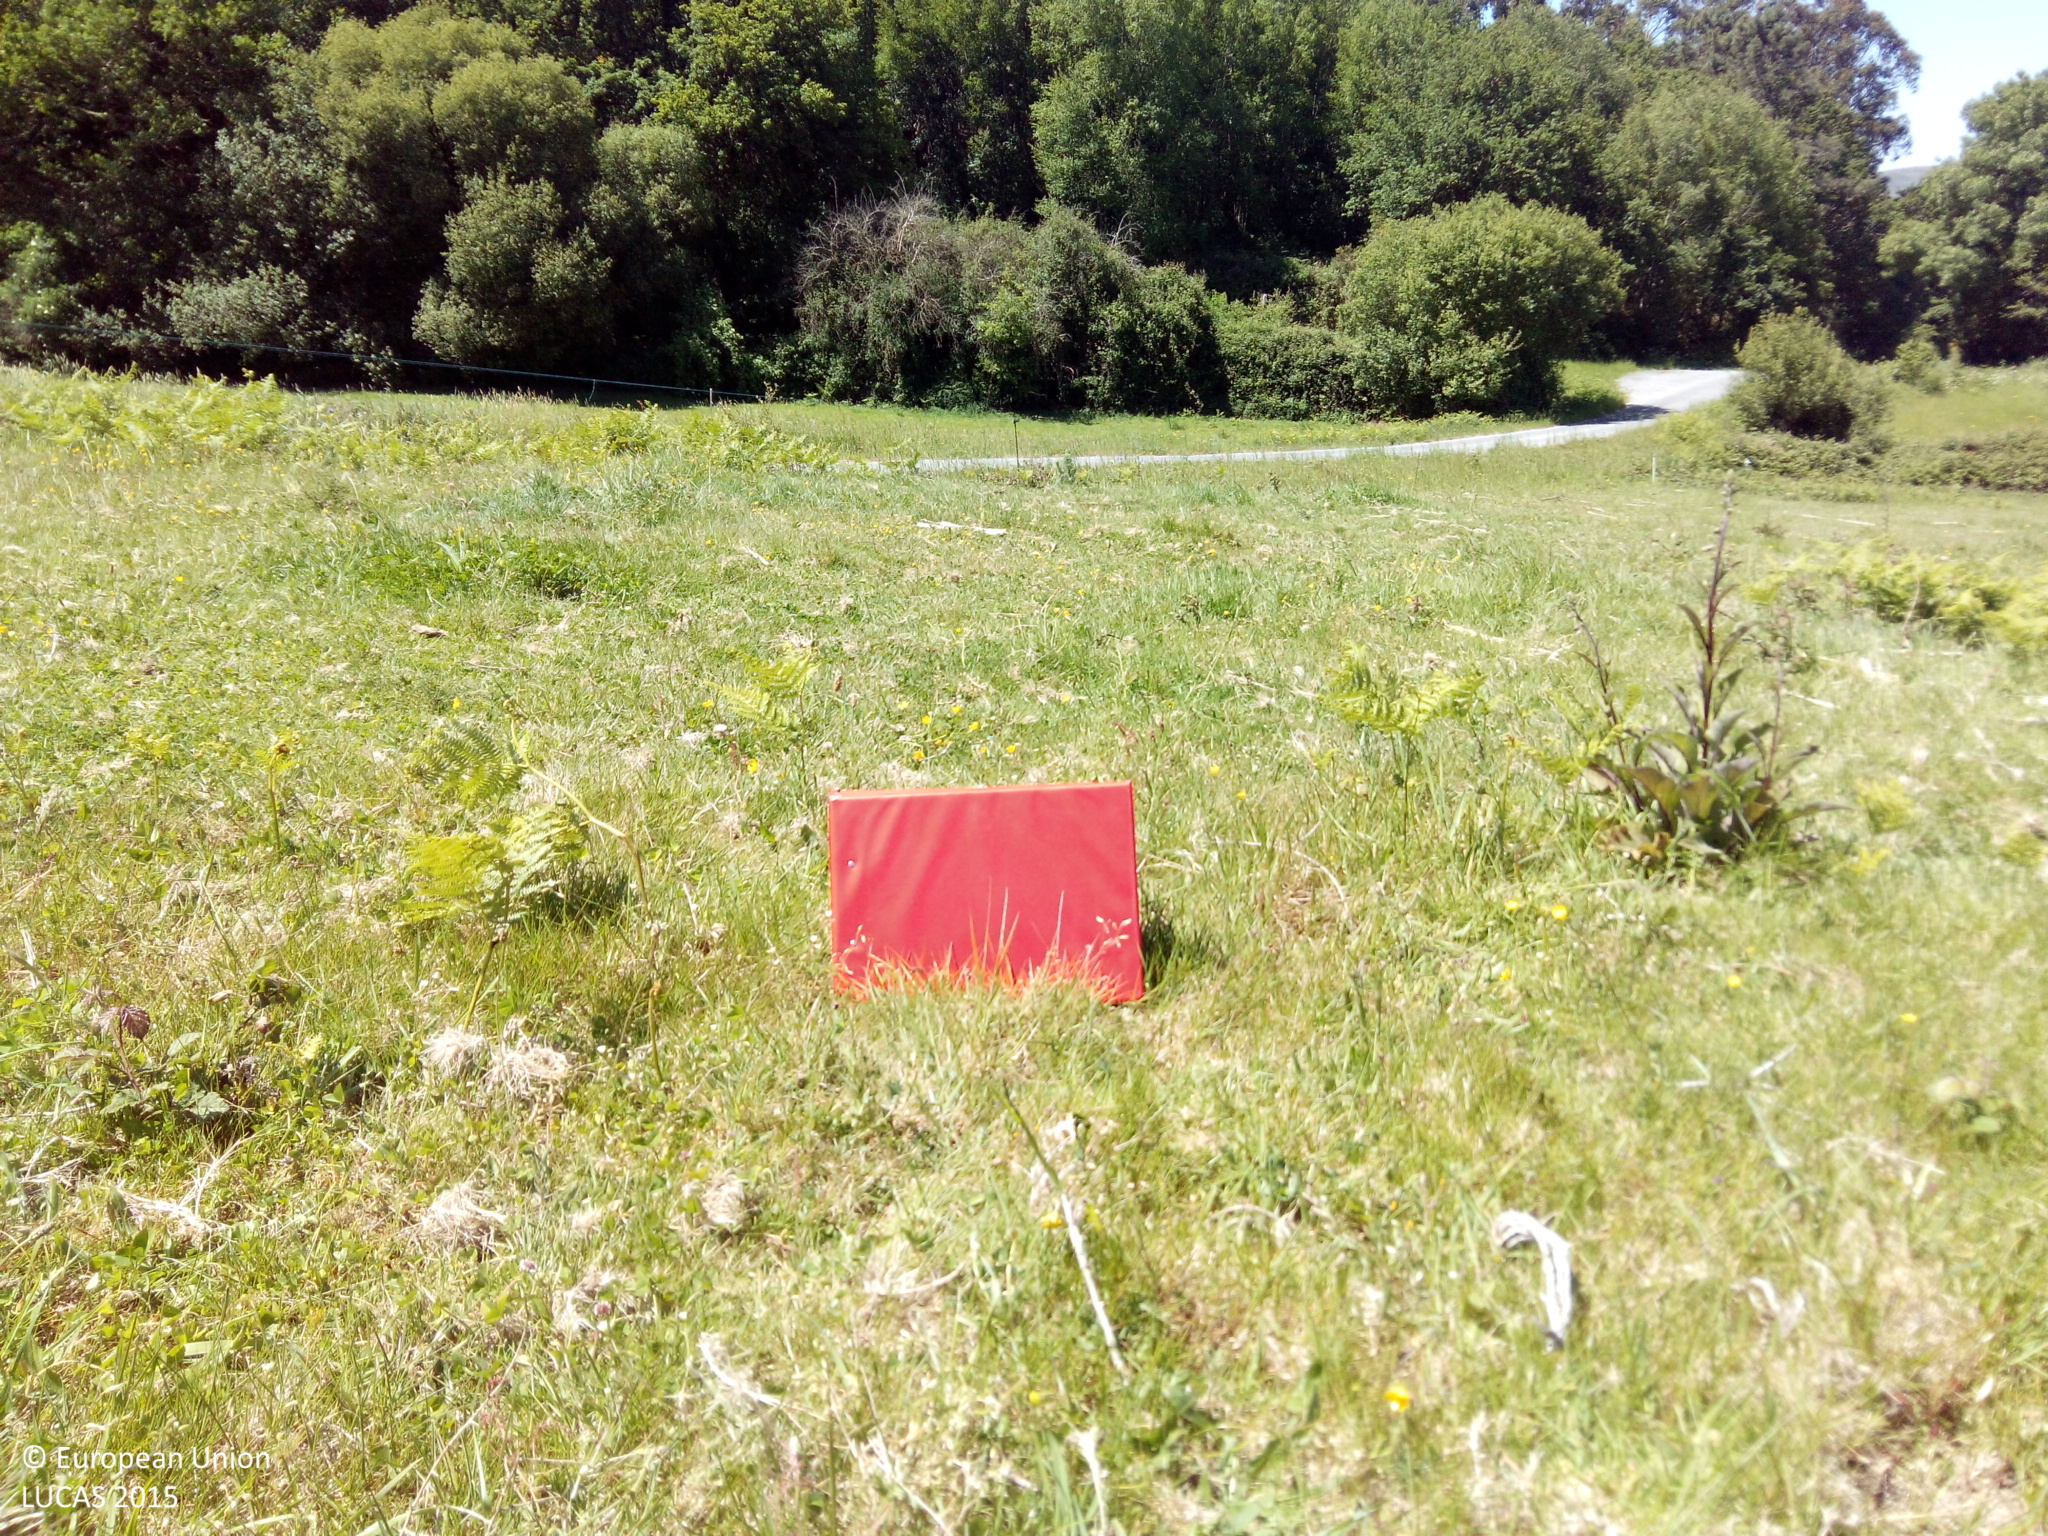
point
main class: Grassland
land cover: Grassland without tree/shrub cover
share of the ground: > 75 %
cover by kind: herbaceous plants 100 %
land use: Agriculture (excluding fallow land and kitchen gardens)
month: May
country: ES
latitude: 42.6451
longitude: -8.4298
